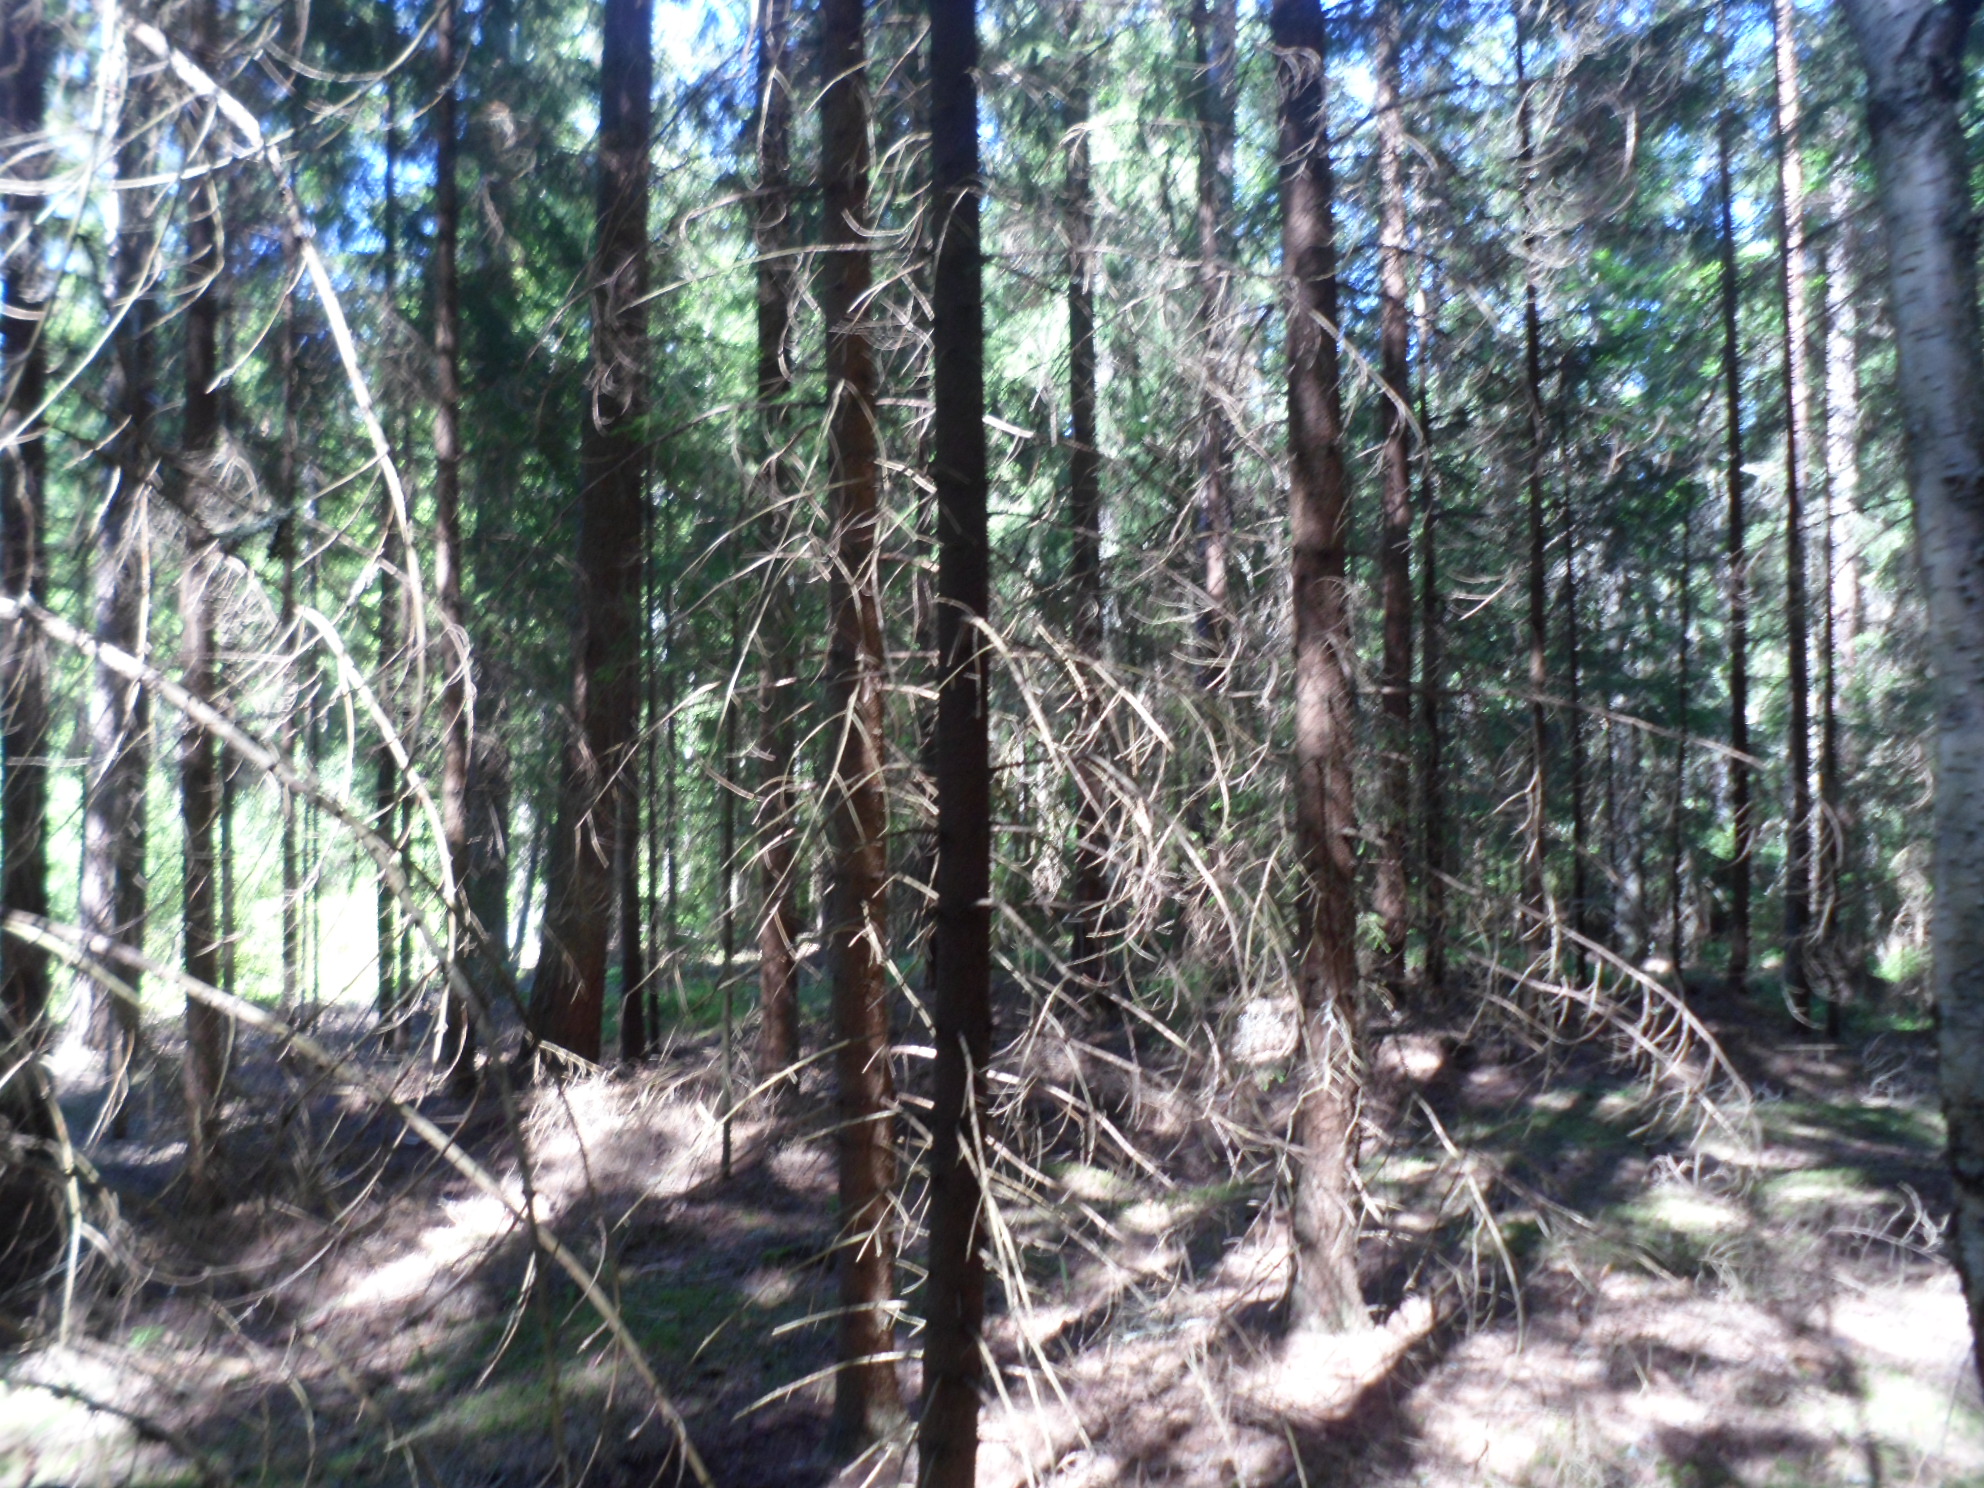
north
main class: Woodland
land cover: Spruce dominated coniferous woodland
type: boreal forest
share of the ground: 50 - 75 %
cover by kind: coniferous forest trees 65 %, lichens and mosses 15 %, unconsolidated bare surface 15 %, herbaceous plants 5 %
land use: Forestry
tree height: > 5 m
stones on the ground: < 10 %
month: July
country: SE
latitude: 57.1879
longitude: 14.5465
